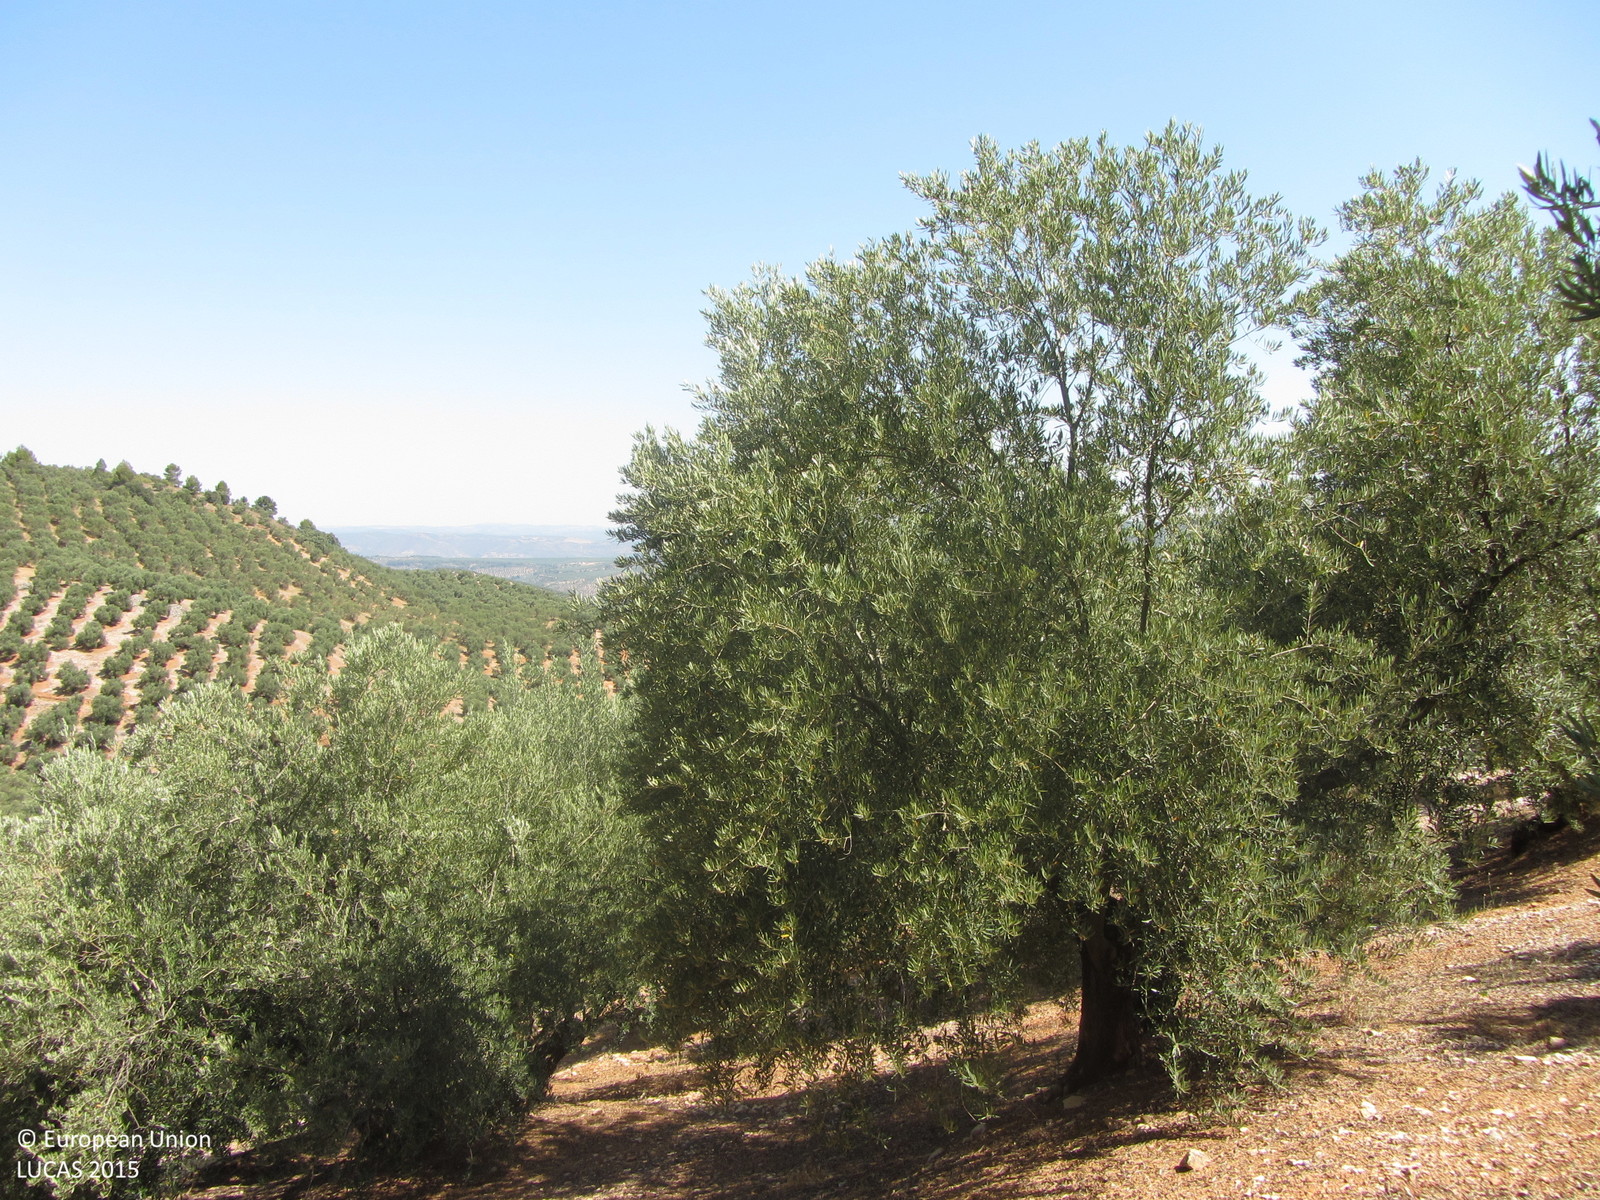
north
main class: Cropland
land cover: Olive groves
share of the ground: 25 - 50 %
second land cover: Other bare soil
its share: > 75 %
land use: Agriculture (excluding fallow land and kitchen gardens)
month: June
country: ES
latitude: 38.2223
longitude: -2.8947
